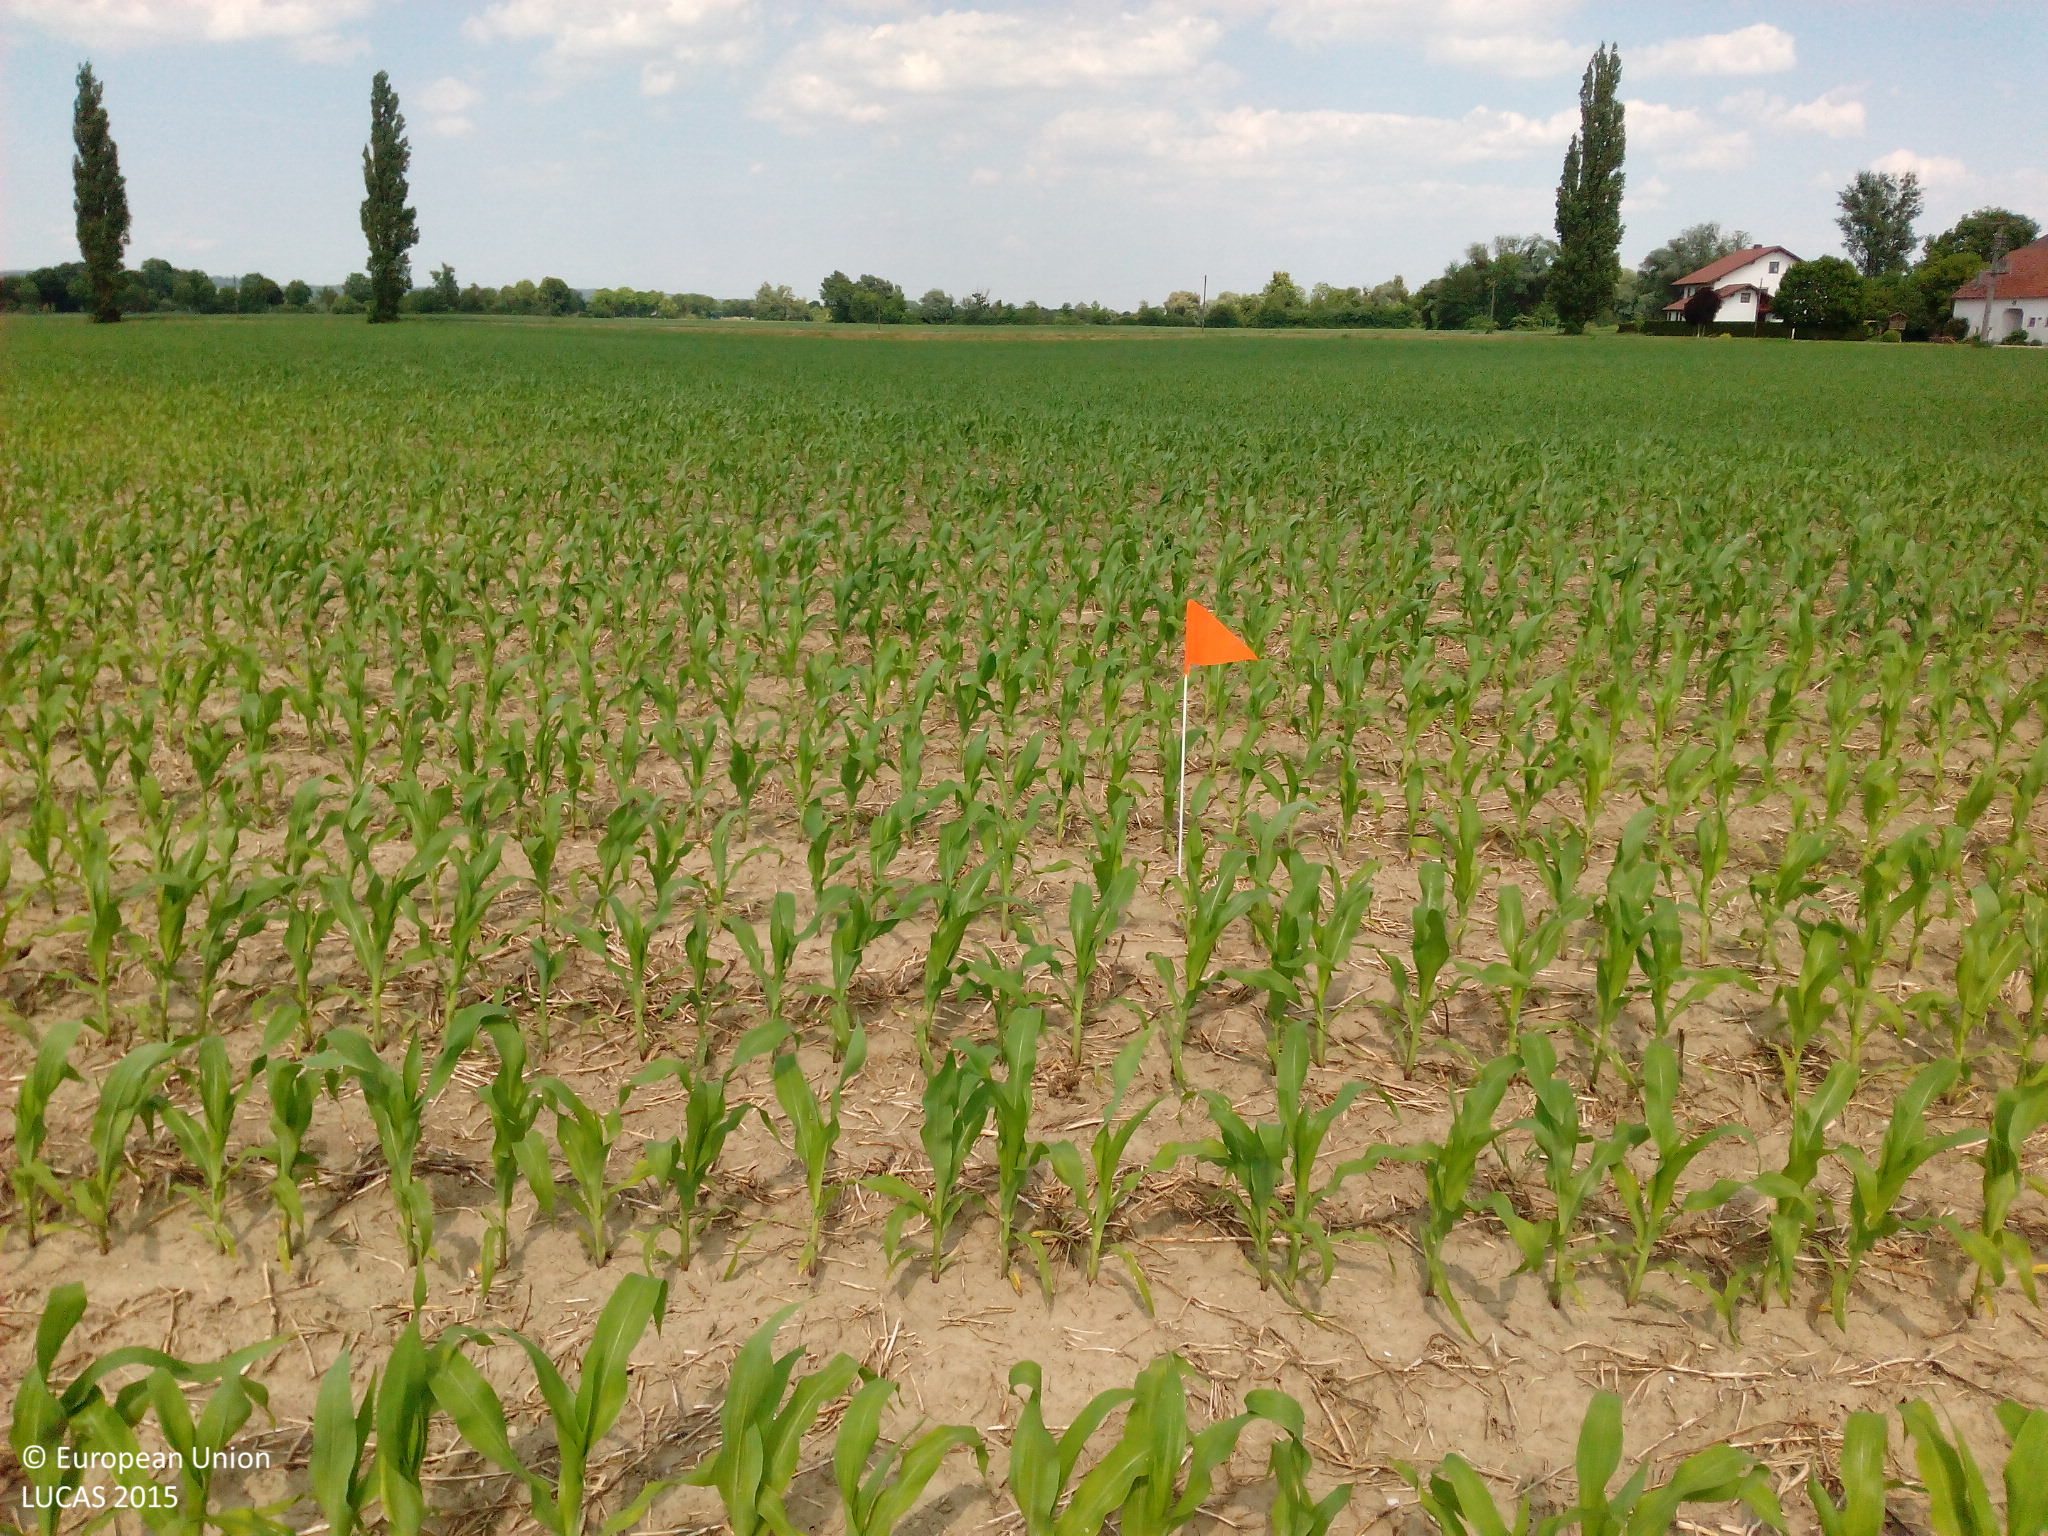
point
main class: Cropland
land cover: Maize
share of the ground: 25 - 50 %
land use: Agriculture (excluding fallow land and kitchen gardens)
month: June
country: DE
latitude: 48.6294
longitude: 12.4008
